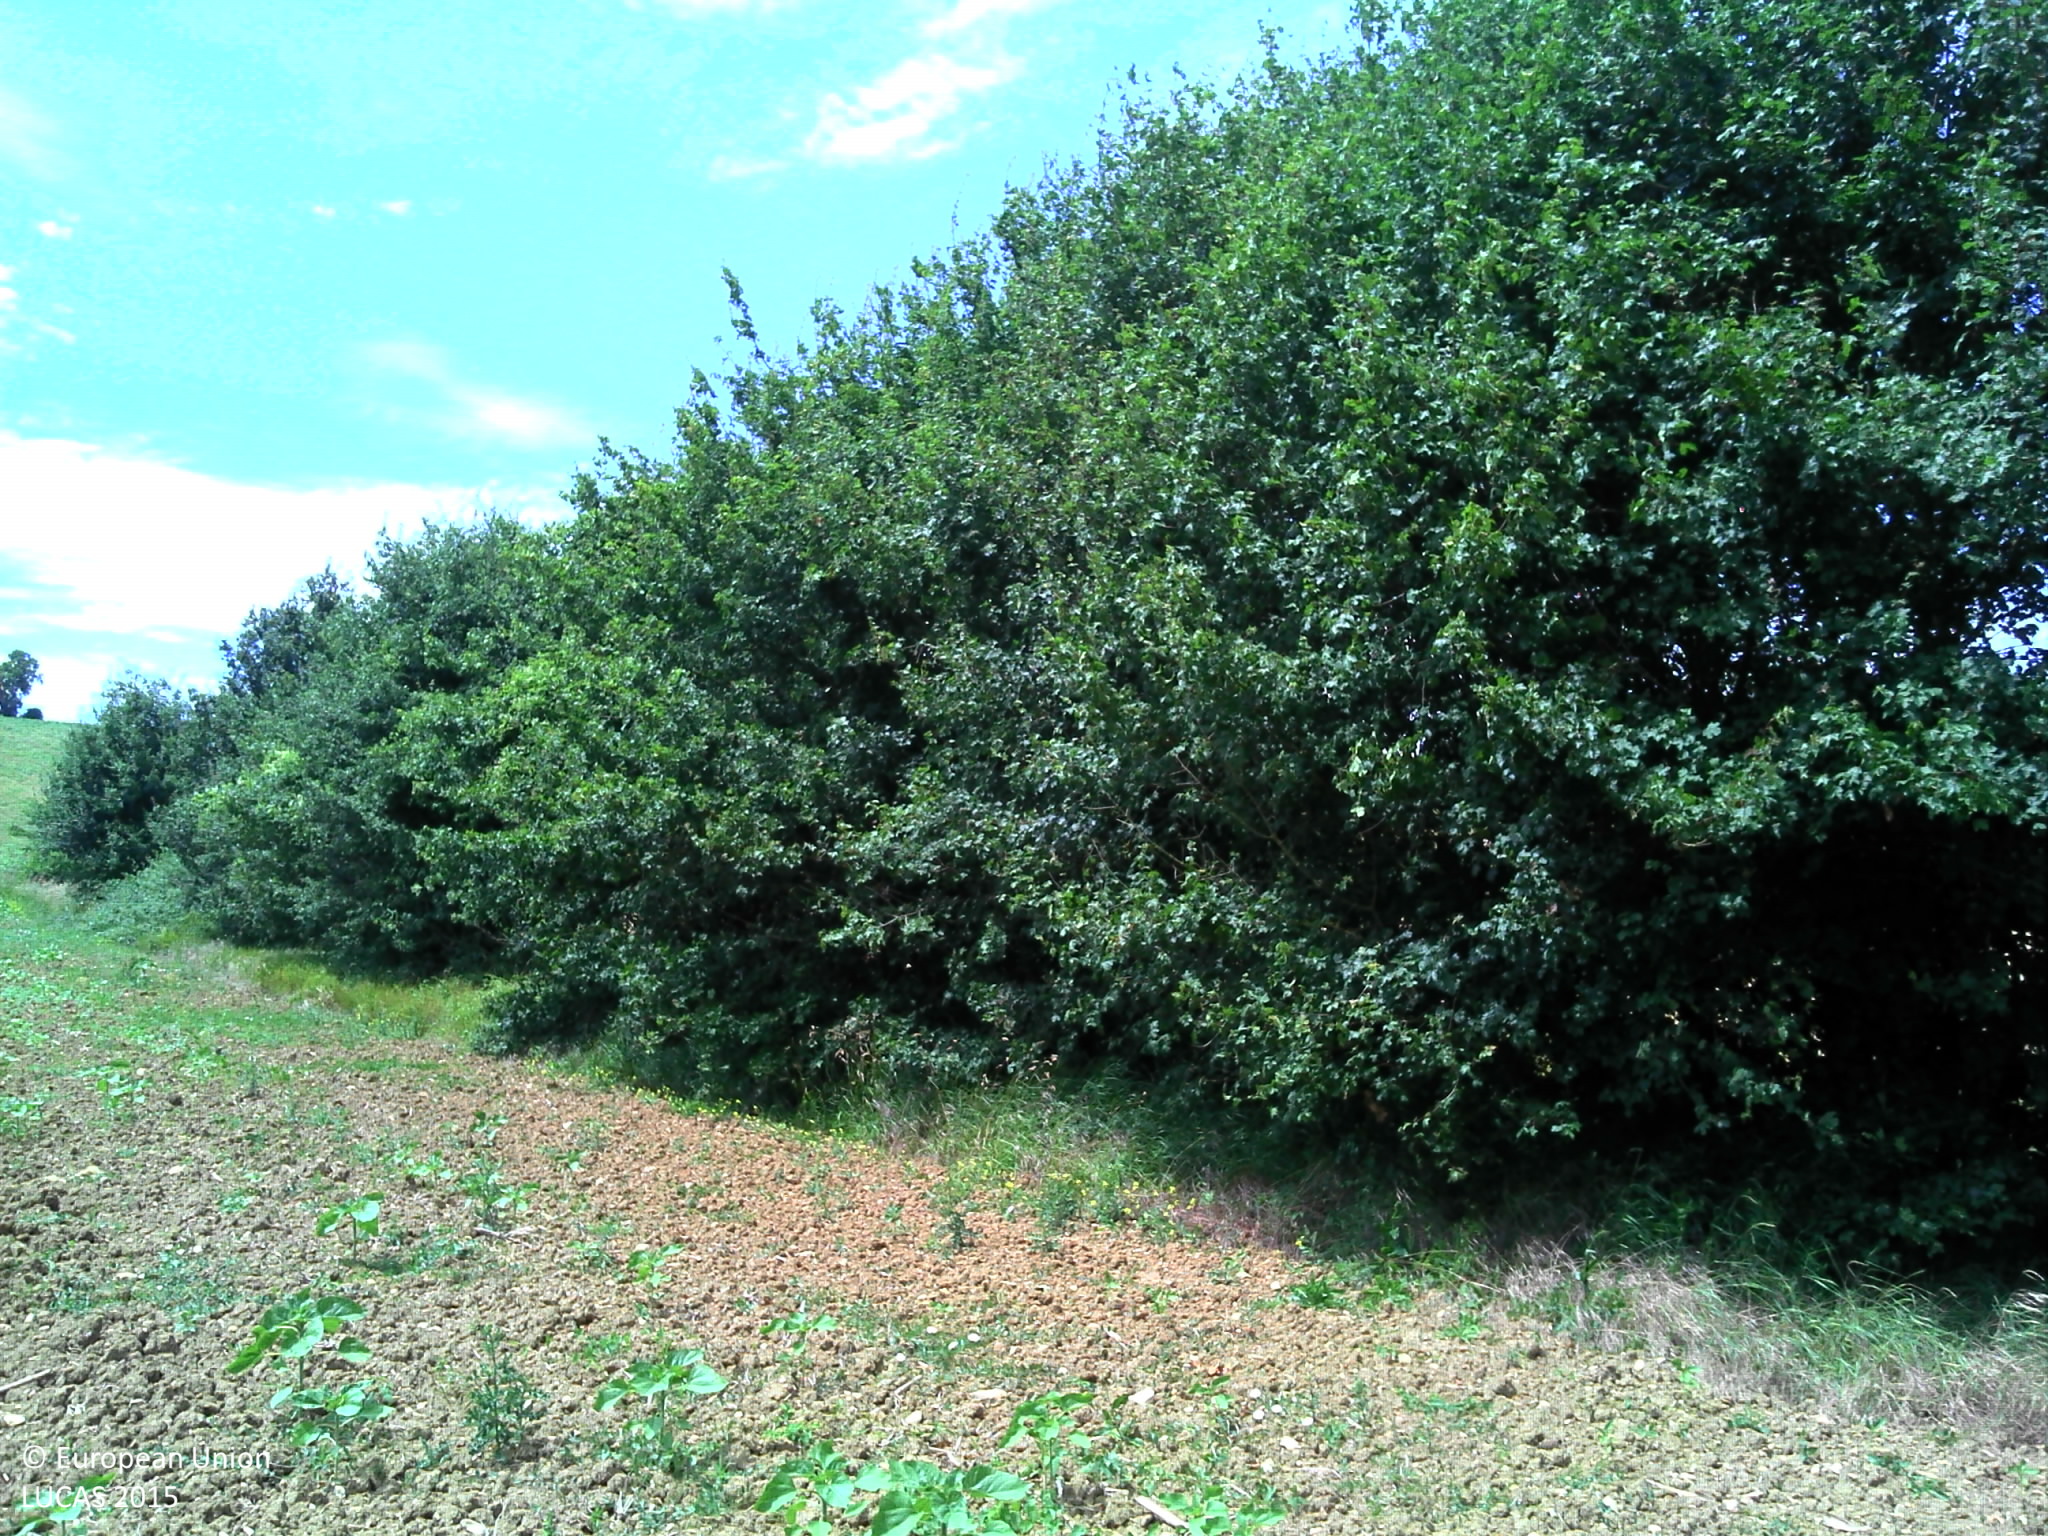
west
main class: Cropland
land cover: Sunflower
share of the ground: < 10 %
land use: Agriculture (excluding fallow land and kitchen gardens)
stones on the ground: > 50 %
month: June
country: FR
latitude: 48.3089
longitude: 0.1704
